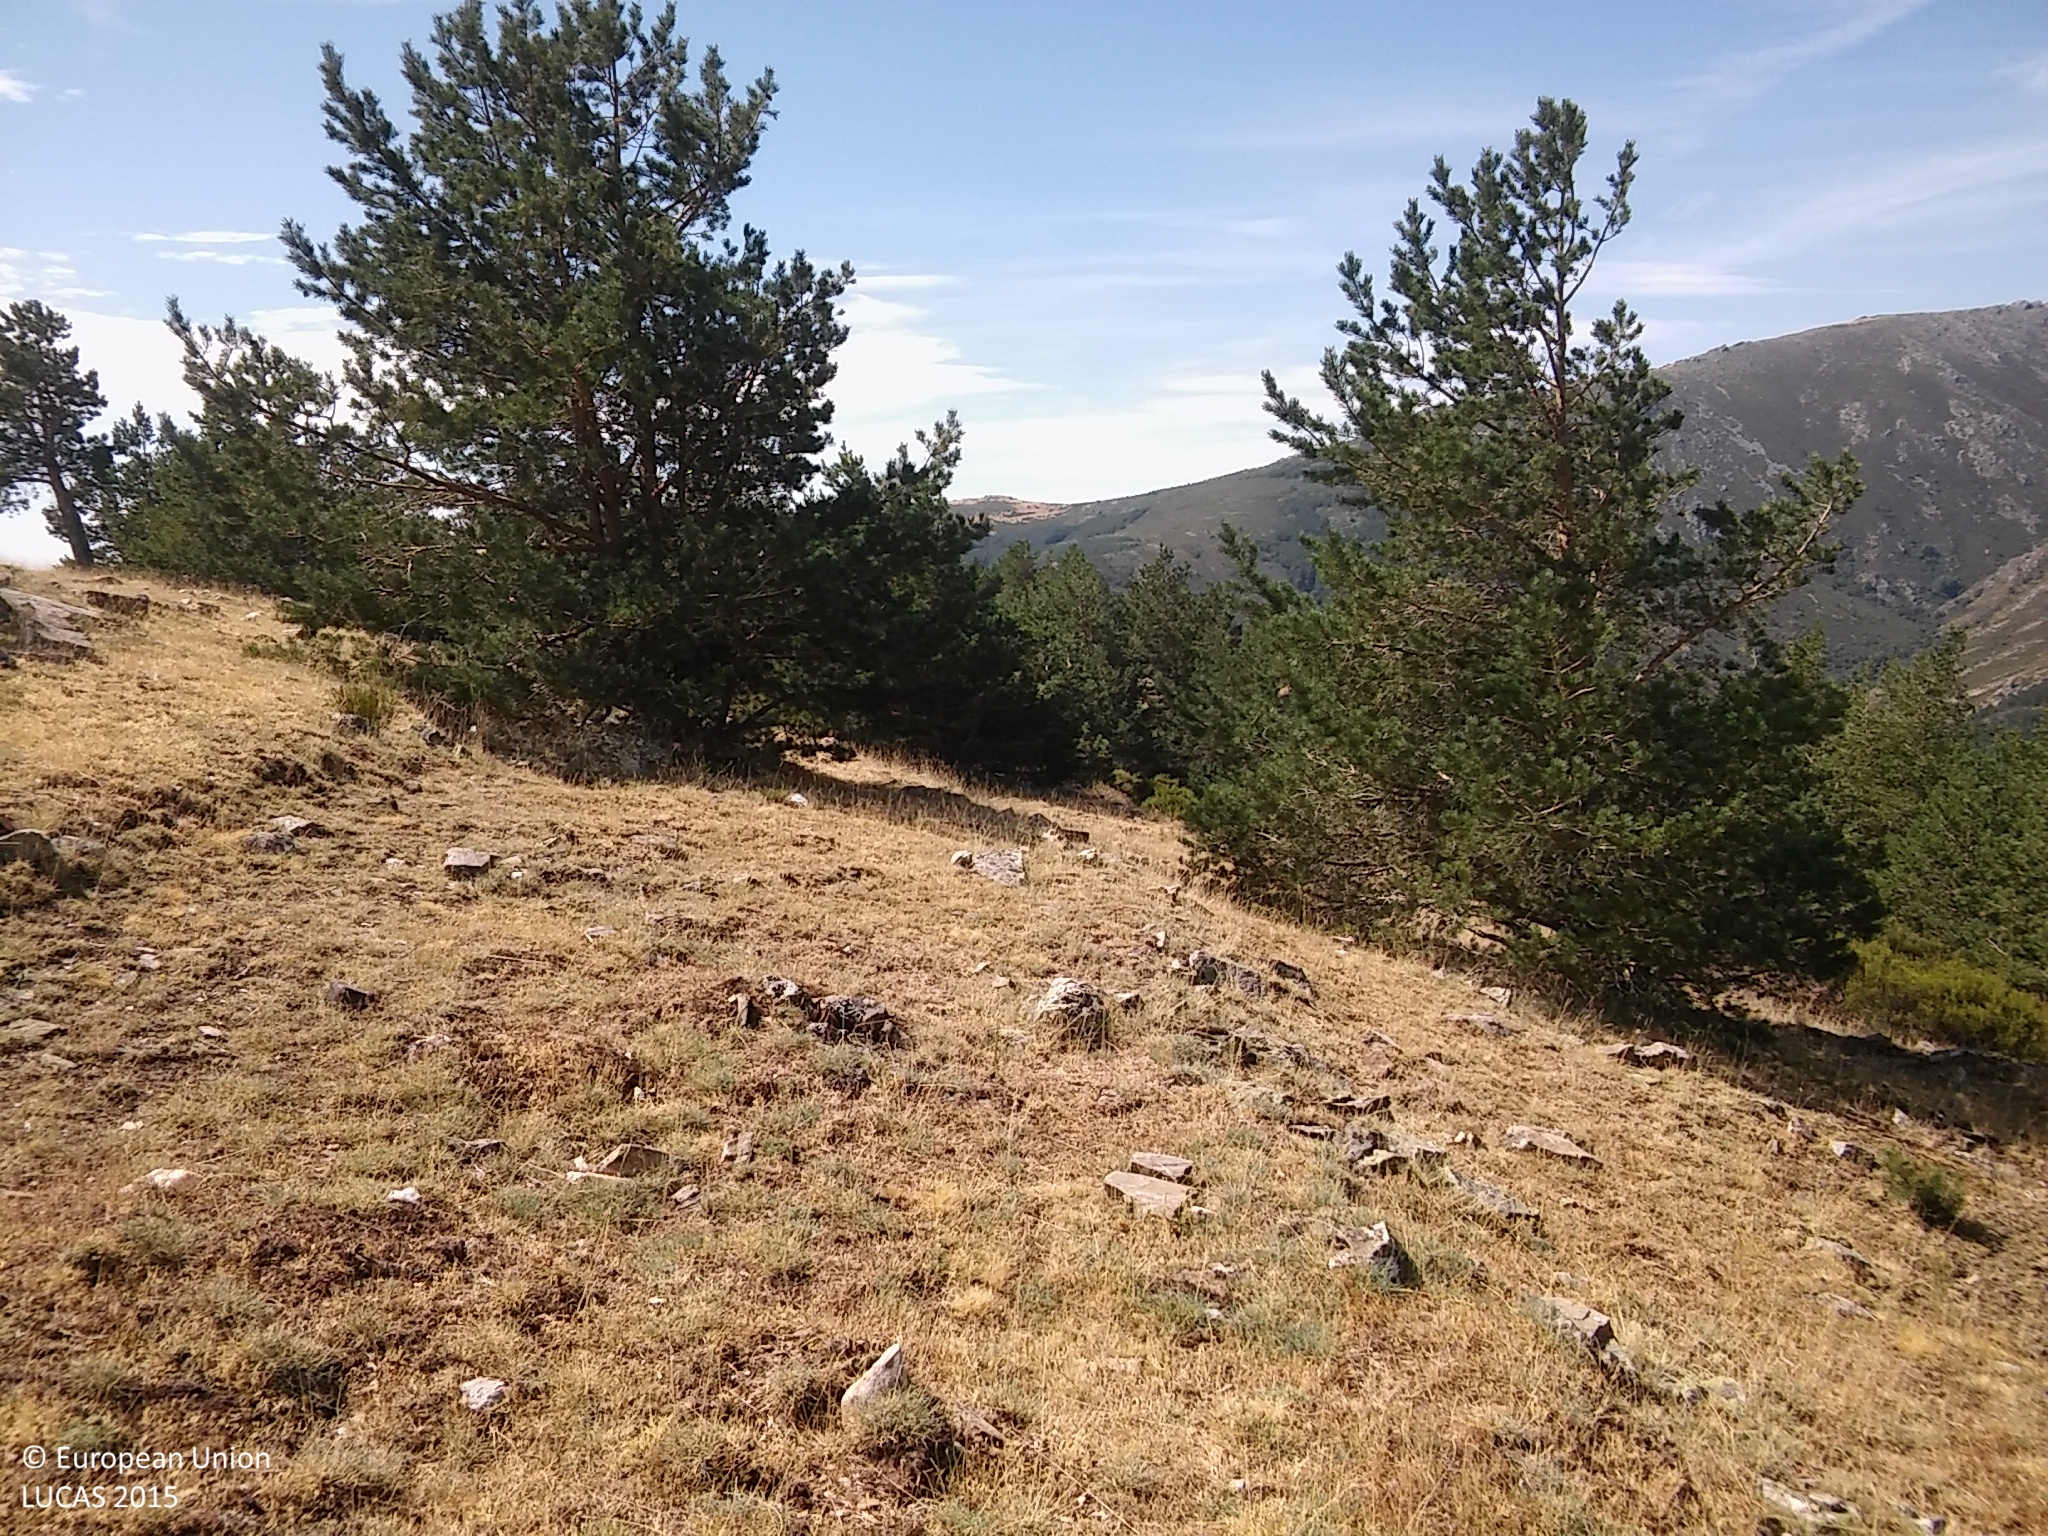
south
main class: Woodland
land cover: Pine dominated coniferous woodland
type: coniferous forest of the mediterranean region
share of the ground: 10 - 25 %
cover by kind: herbaceous plants 85 %, coniferous forest trees 15 %
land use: Forestry
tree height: > 5 m
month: August
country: ES
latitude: 41.1910
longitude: -3.4089
